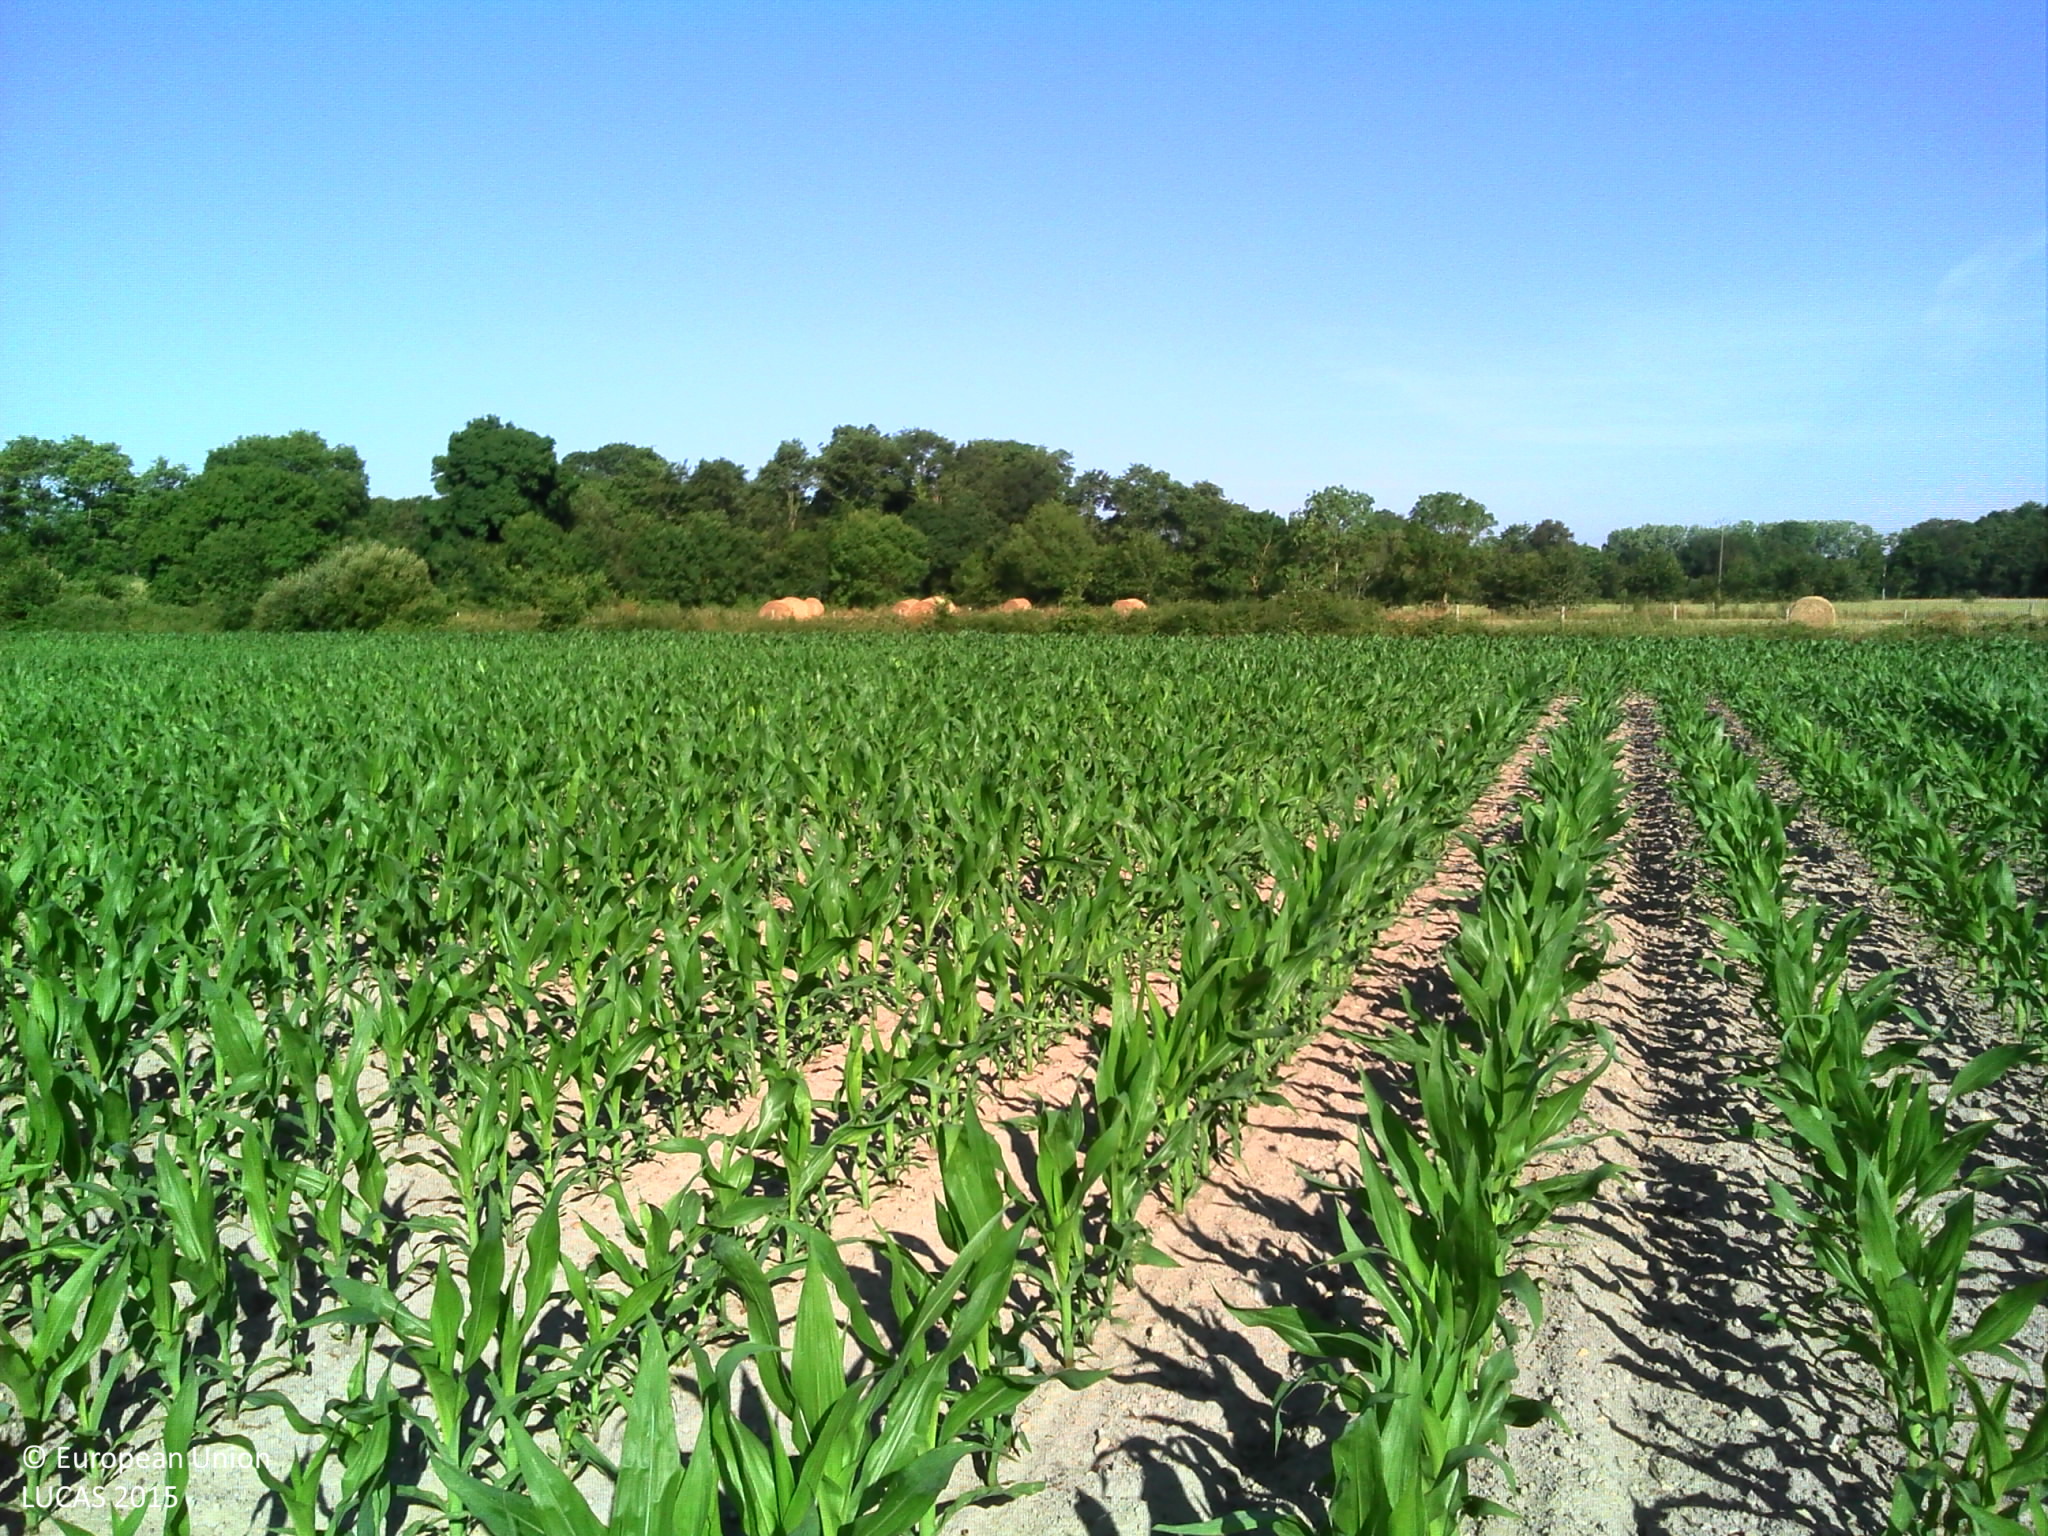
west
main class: Cropland
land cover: Maize
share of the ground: 25 - 50 %
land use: Agriculture (excluding fallow land and kitchen gardens)
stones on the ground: 10 - 25 %
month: June
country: FR
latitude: 46.9767
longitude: -1.7295
